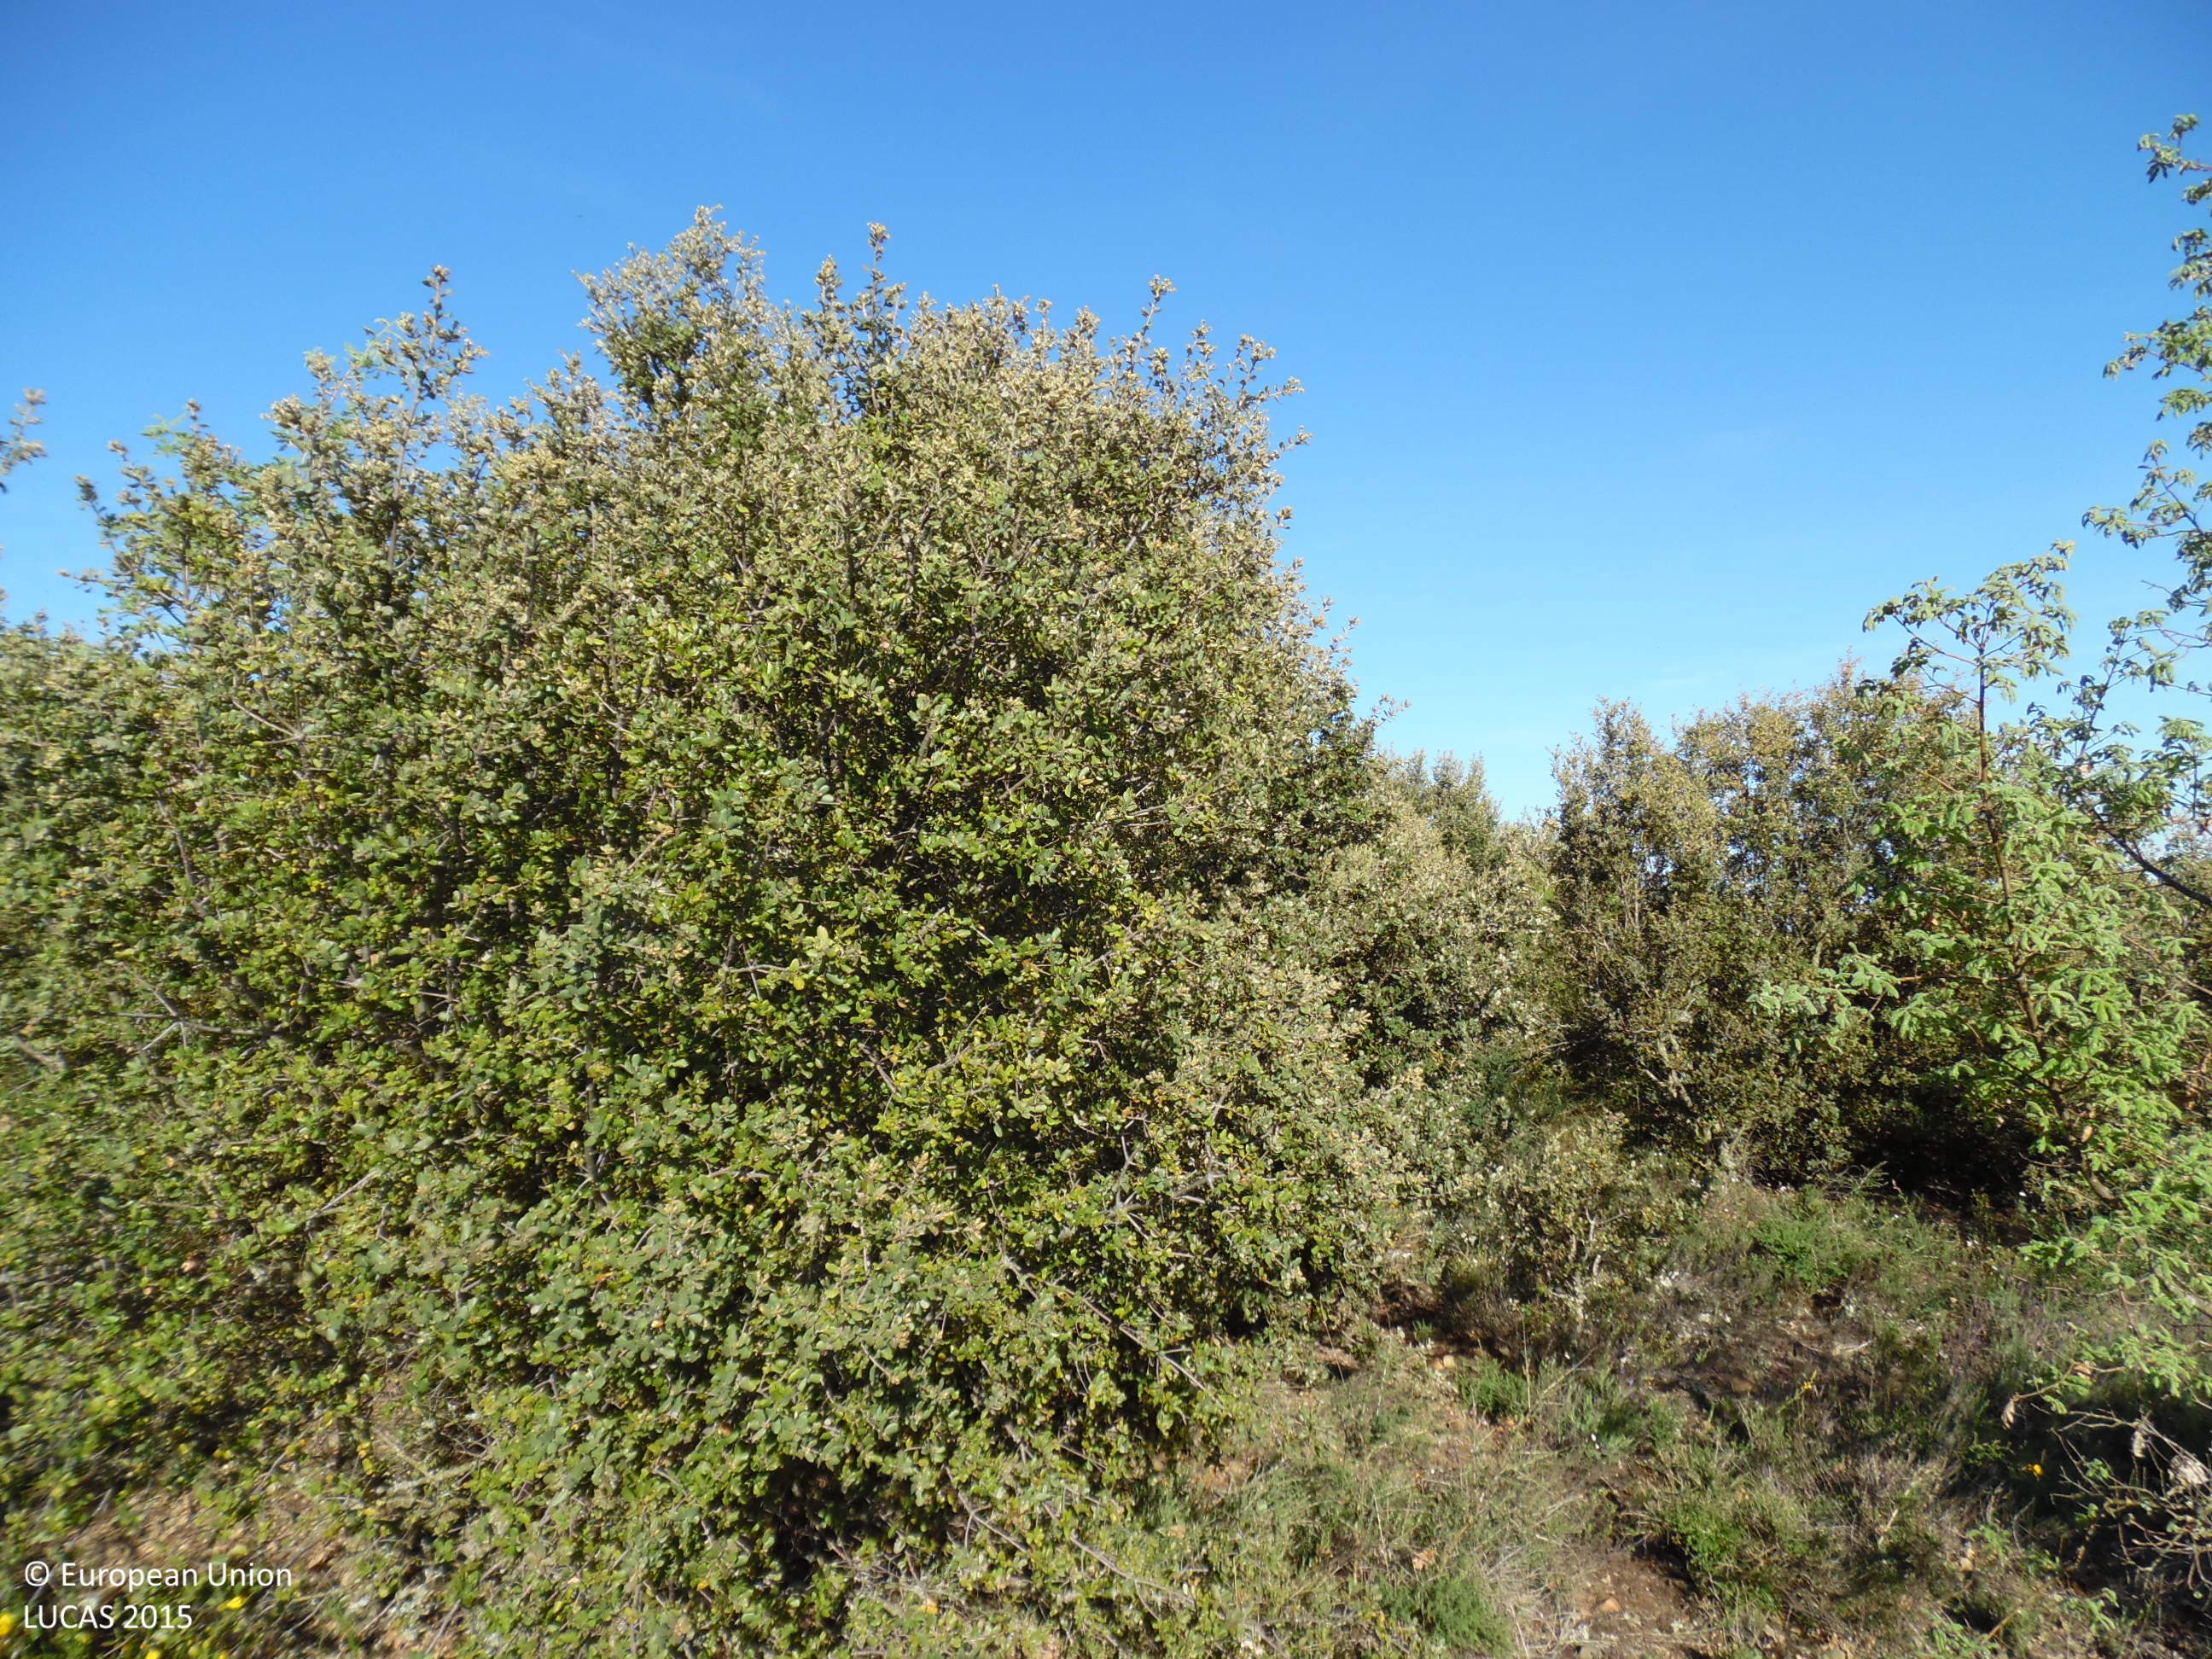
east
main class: Woodland
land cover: Broadleaved woodland
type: acidophilous oak and oak-birch forest
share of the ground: > 75 %
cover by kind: broadleaved forest trees 70 %, shrubs 20 %, herbaceous plants 10 %
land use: Abandoned areas
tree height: < 5 m
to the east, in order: Broadleaved woodland; Shrubland with sparse tree cover; Grassland with sparse tree/shrub cover; Tracks; Shrubland without tree cover; Tracks; Broadleaved woodland; Shrubland with sparse tree cover; Grass margins; Tracks; Shrubland with sparse tree cover
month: May
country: ES
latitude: 42.6180
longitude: -5.7925
